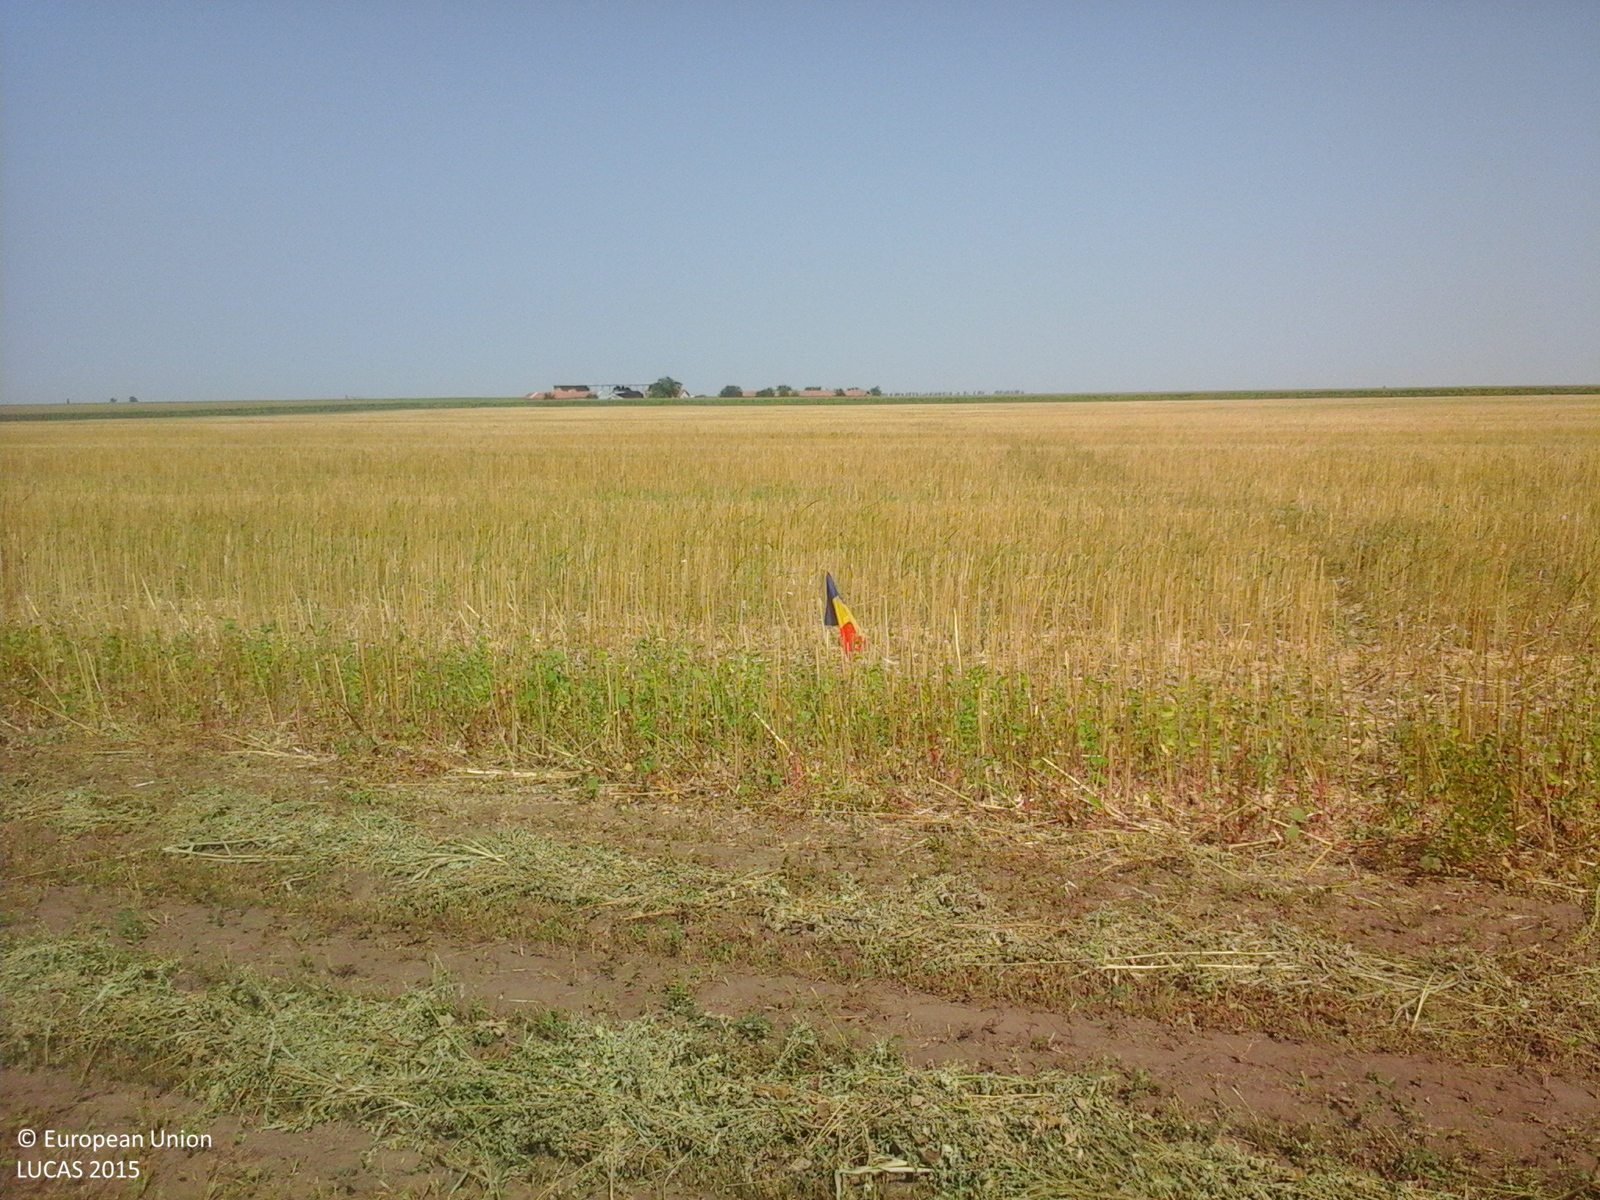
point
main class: Cropland
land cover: Rape and turnip rape
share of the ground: 25 - 50 %
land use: Agriculture (excluding fallow land and kitchen gardens)
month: July
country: RO
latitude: 44.7462
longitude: 27.1745
